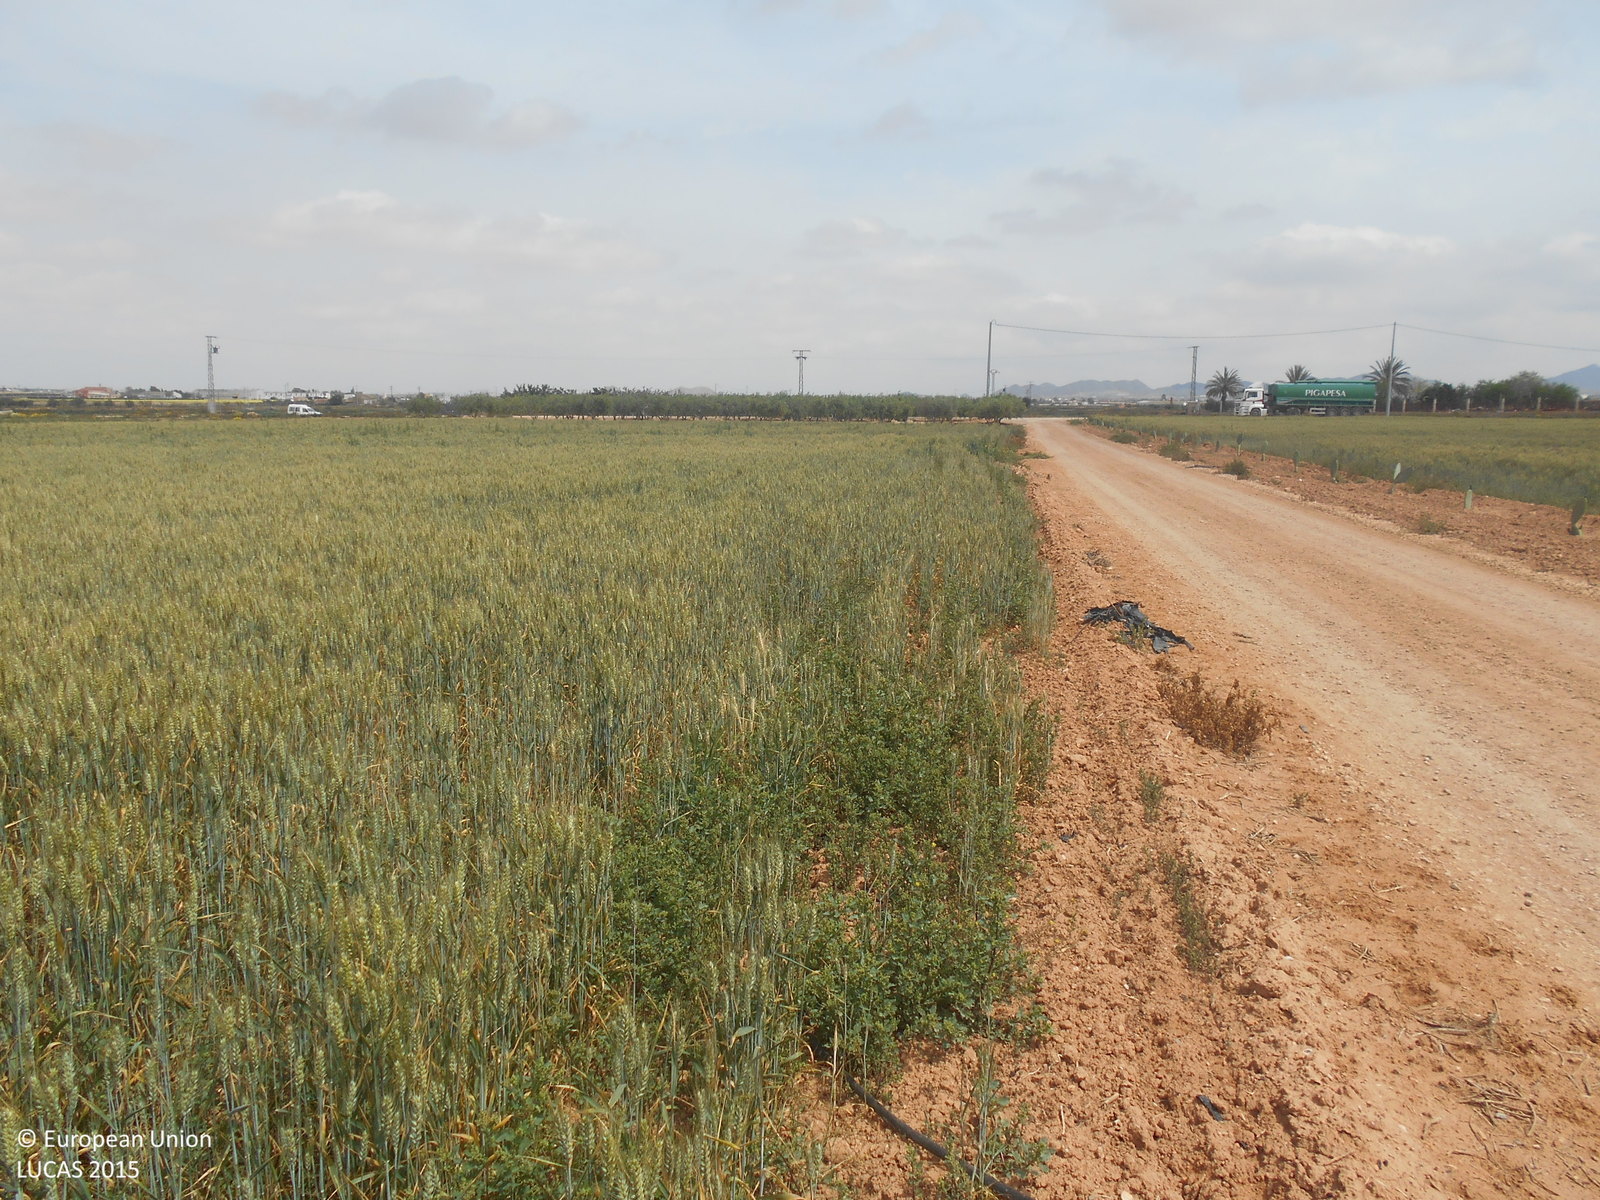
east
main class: Cropland
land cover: Durum wheat
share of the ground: > 75 %
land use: Agriculture (excluding fallow land and kitchen gardens)
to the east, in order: Durum wheat; Olive groves; Paved roads, cycling and walking lanes; Grass margins; Fences; Spontaneously vegetated surfaces; Tracks; Grass margins
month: April
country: ES
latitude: 37.7211
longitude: -1.2239
